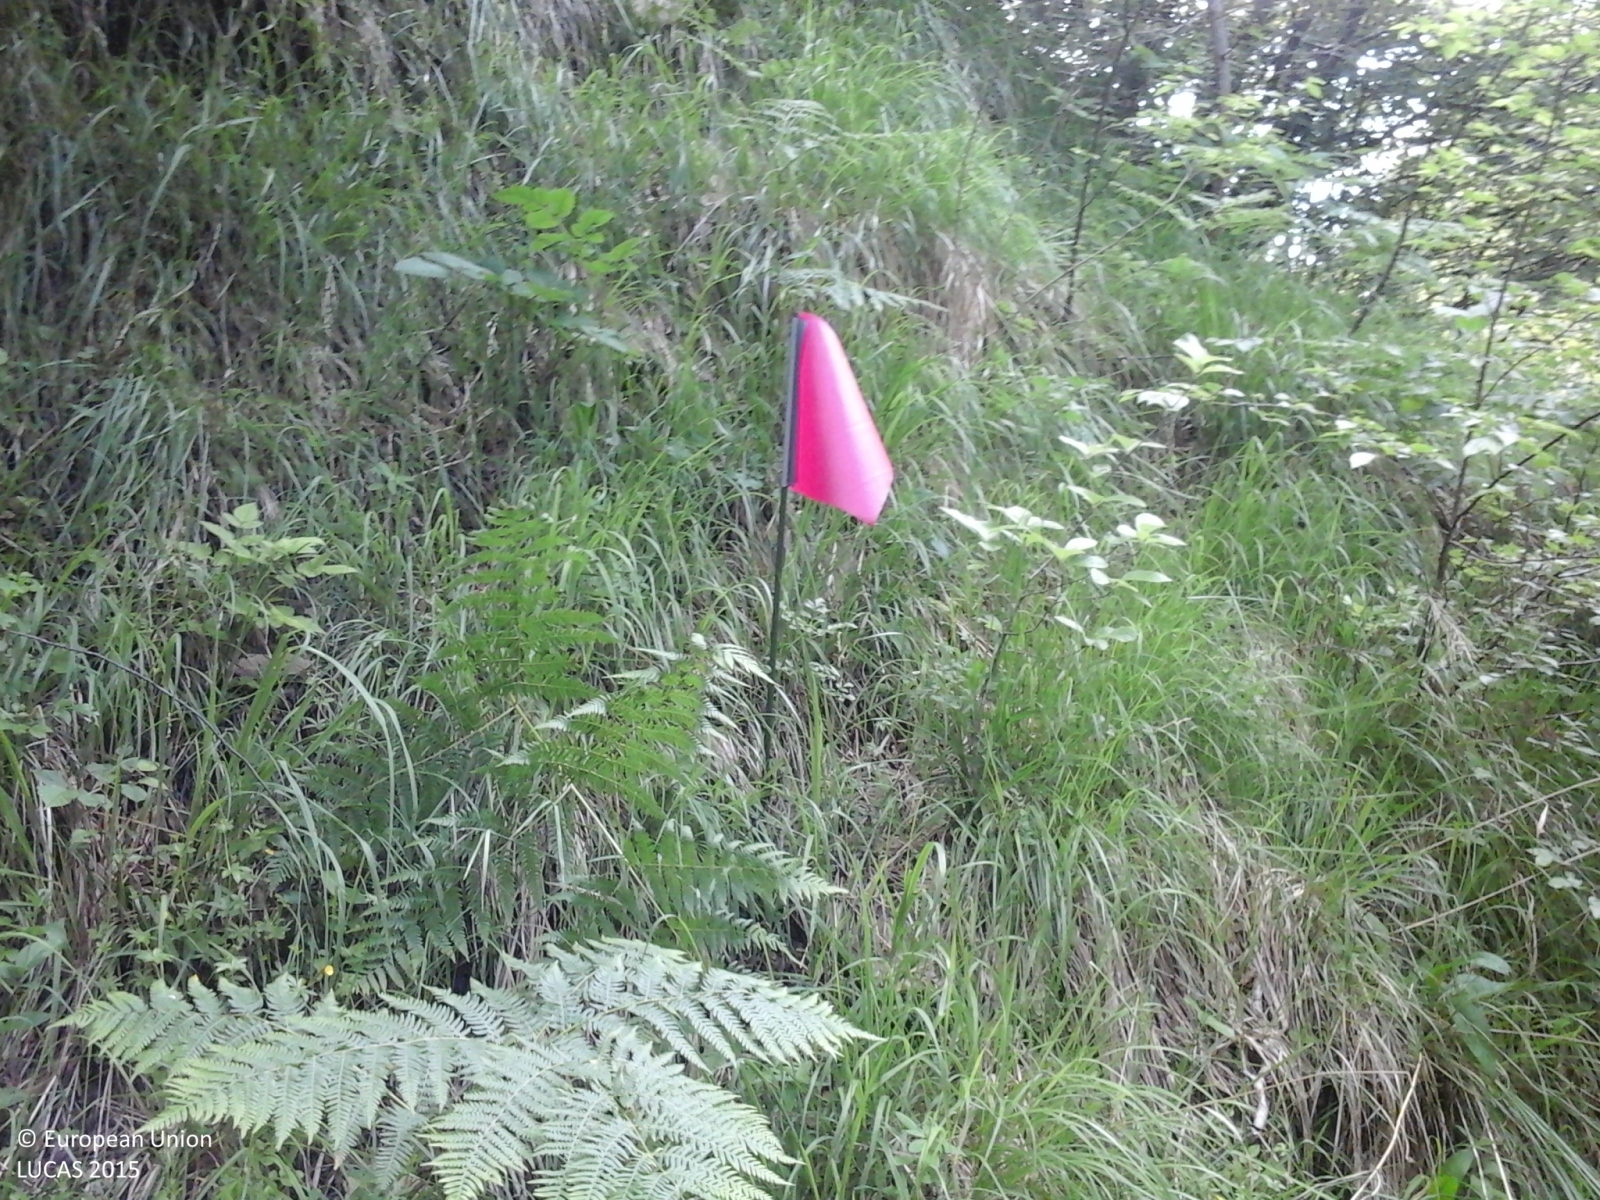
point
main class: Woodland
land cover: Other mixed woodland
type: mesophytic deciduous forest
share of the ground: > 75 %
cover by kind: broadleaved forest trees 75 %, coniferous forest trees 25 %
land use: Semi-natural and natural areas not in use
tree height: > 5 m
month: June
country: IT
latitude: 46.0936
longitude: 12.2348
